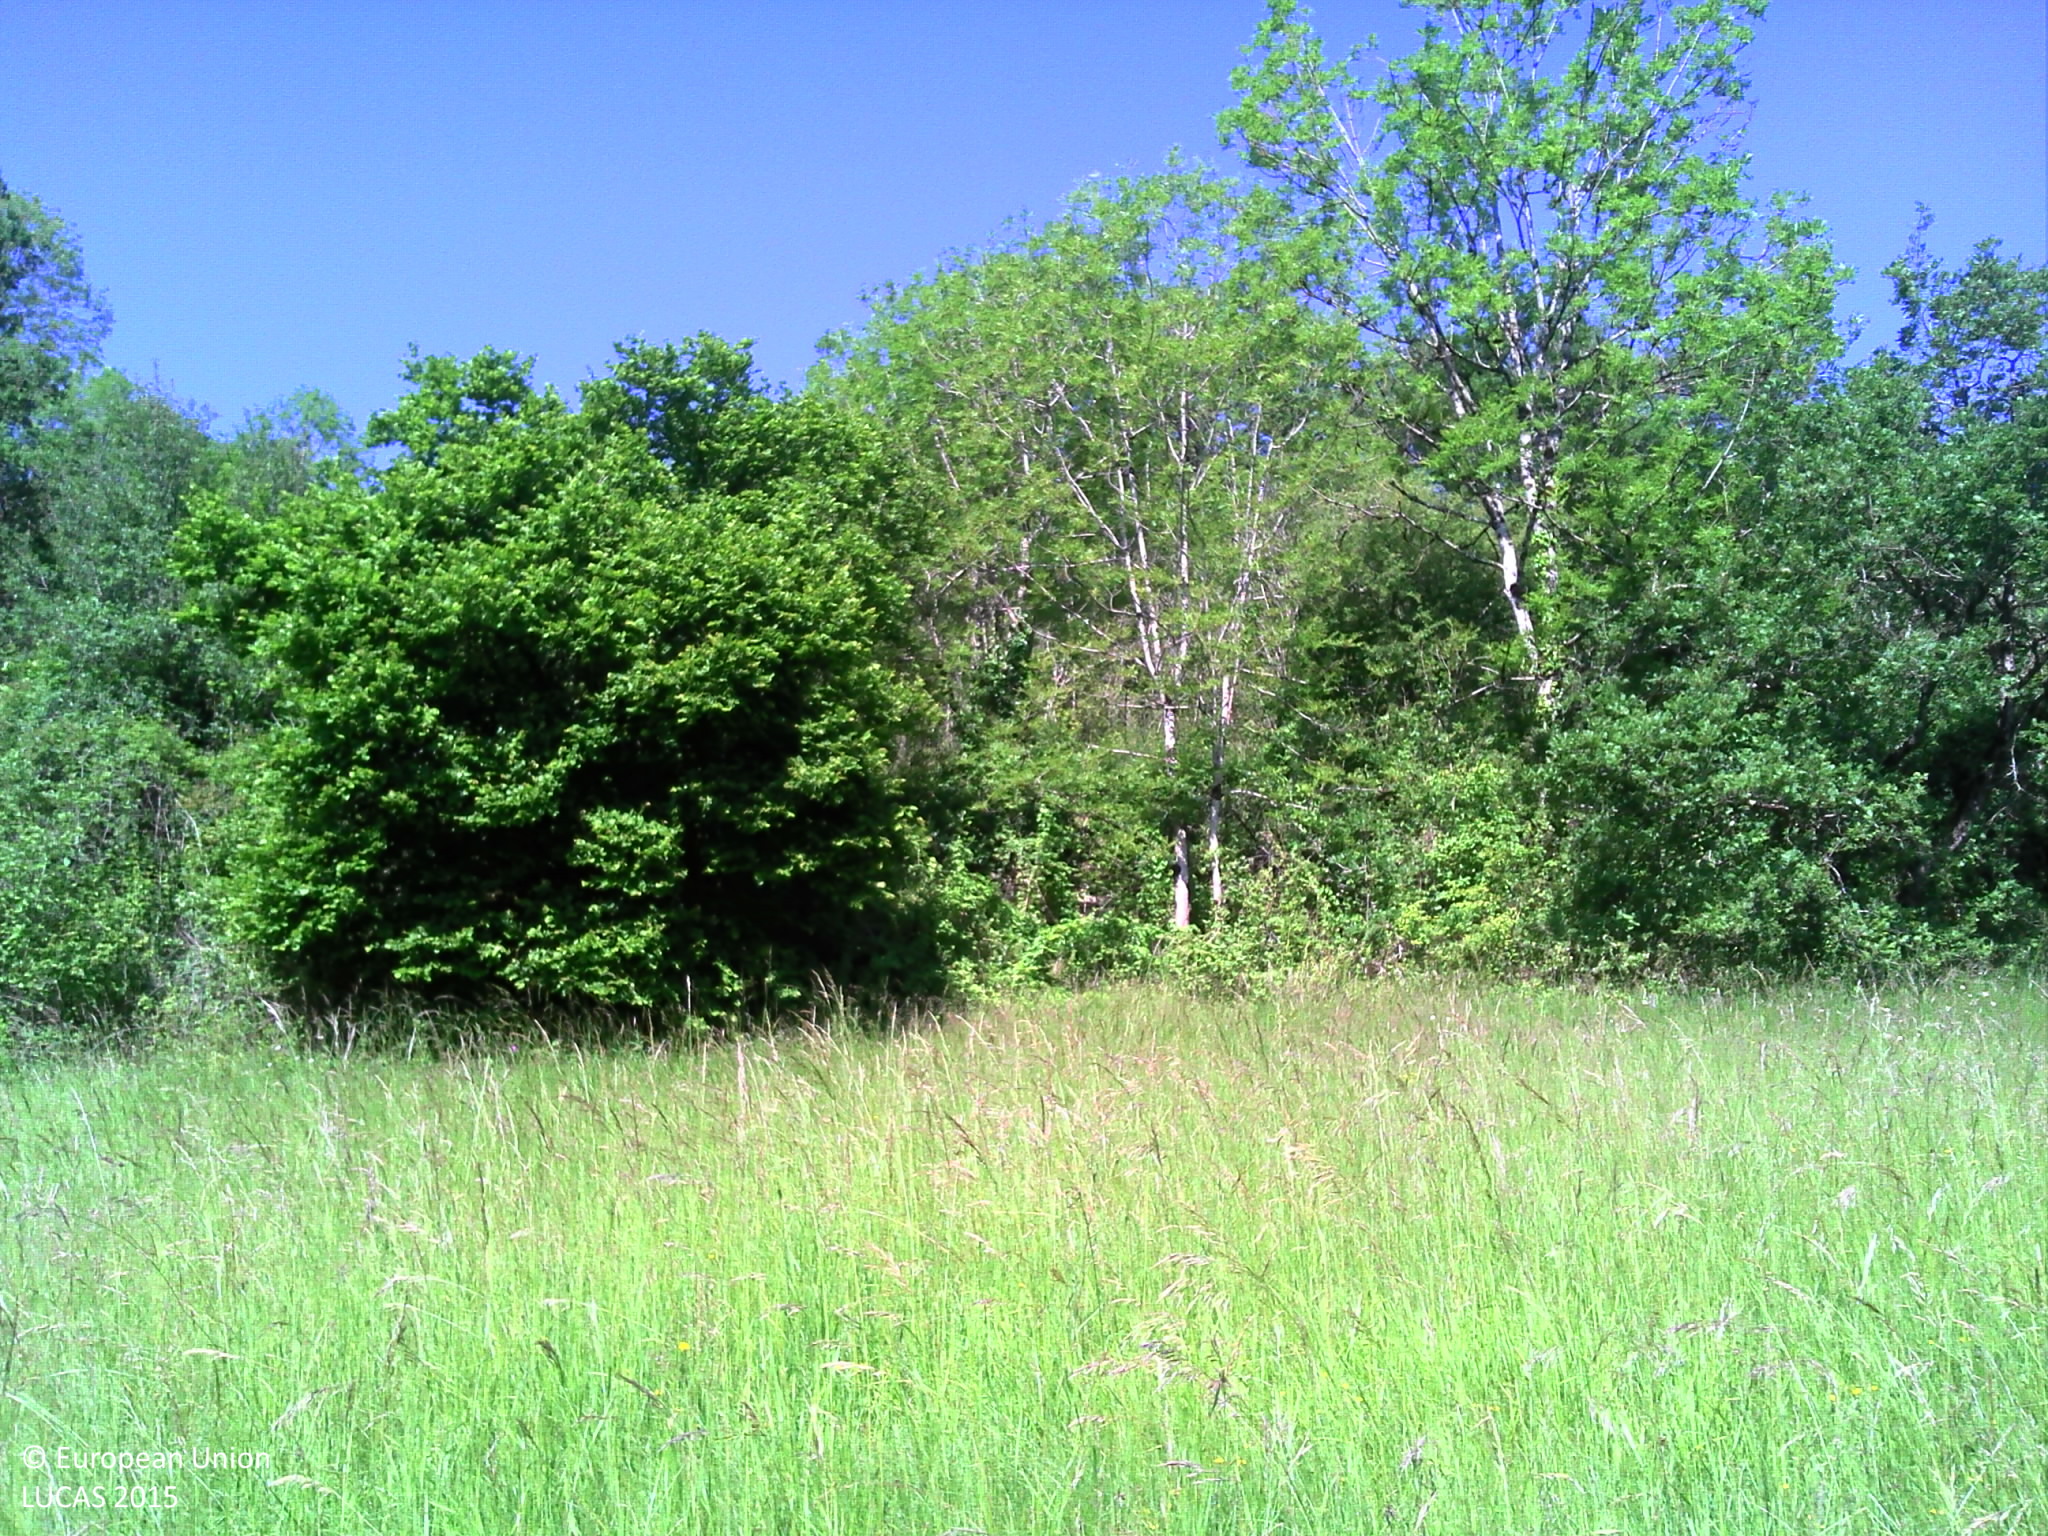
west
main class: Grassland
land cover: Grassland without tree/shrub cover
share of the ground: > 75 %
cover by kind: herbaceous plants 100 %
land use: Agriculture (excluding fallow land and kitchen gardens)
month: May
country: FR
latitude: 44.5671
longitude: 2.0047
